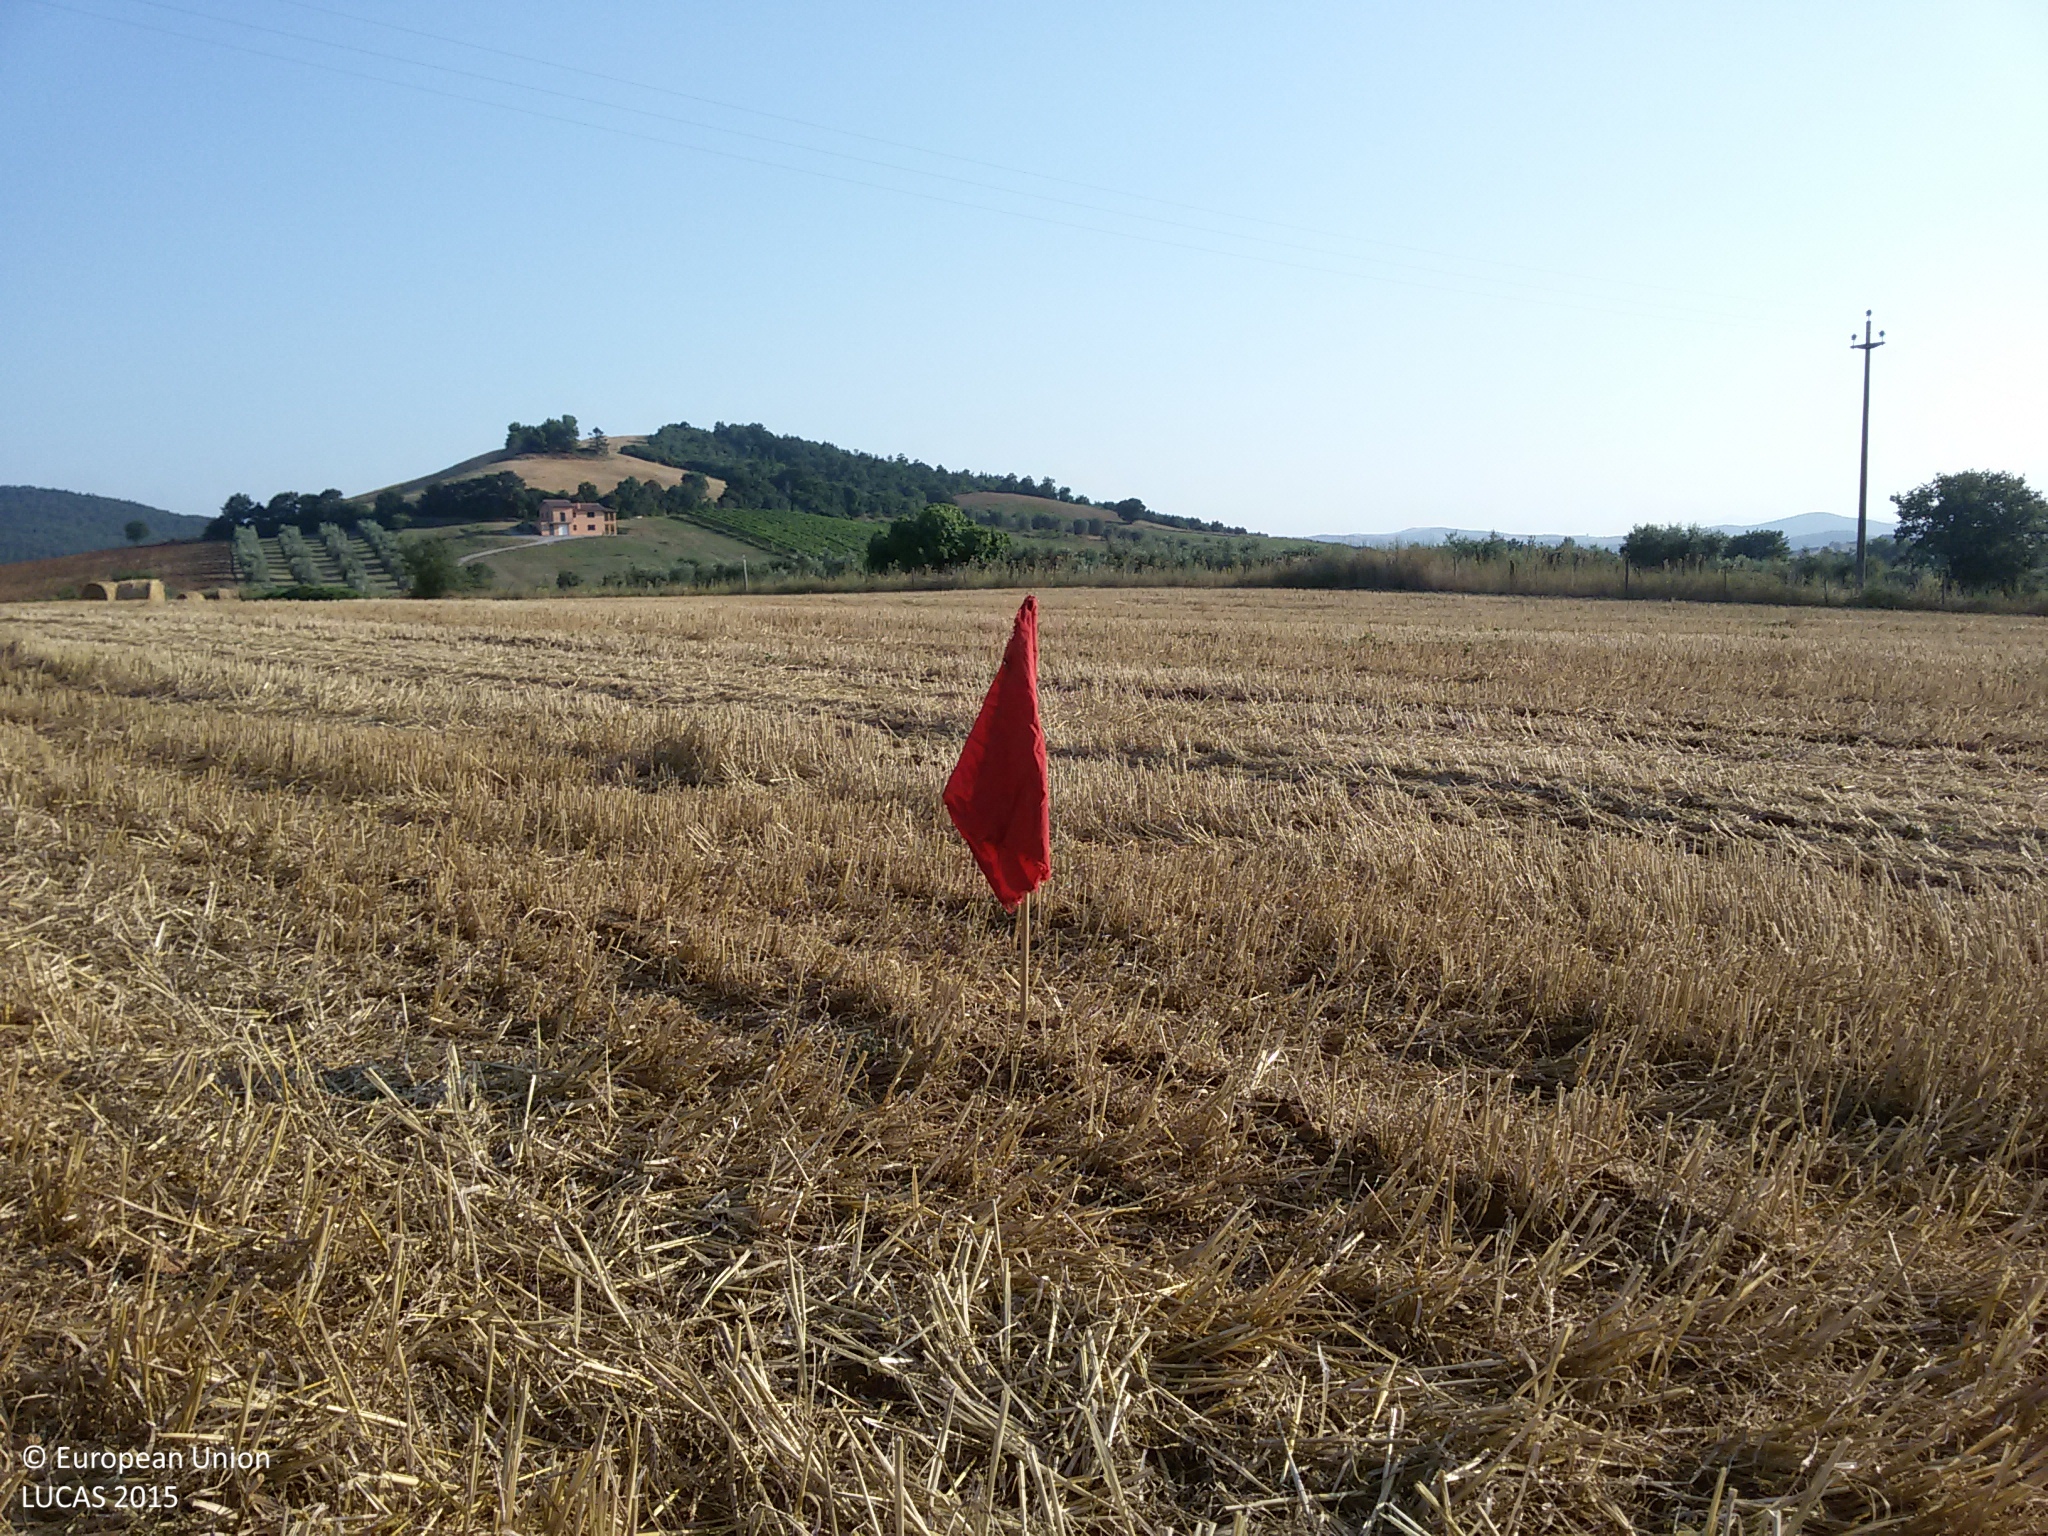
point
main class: Cropland
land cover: Durum wheat
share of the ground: > 75 %
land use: Agriculture (excluding fallow land and kitchen gardens)
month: July
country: IT
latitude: 42.5531
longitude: 11.4687
